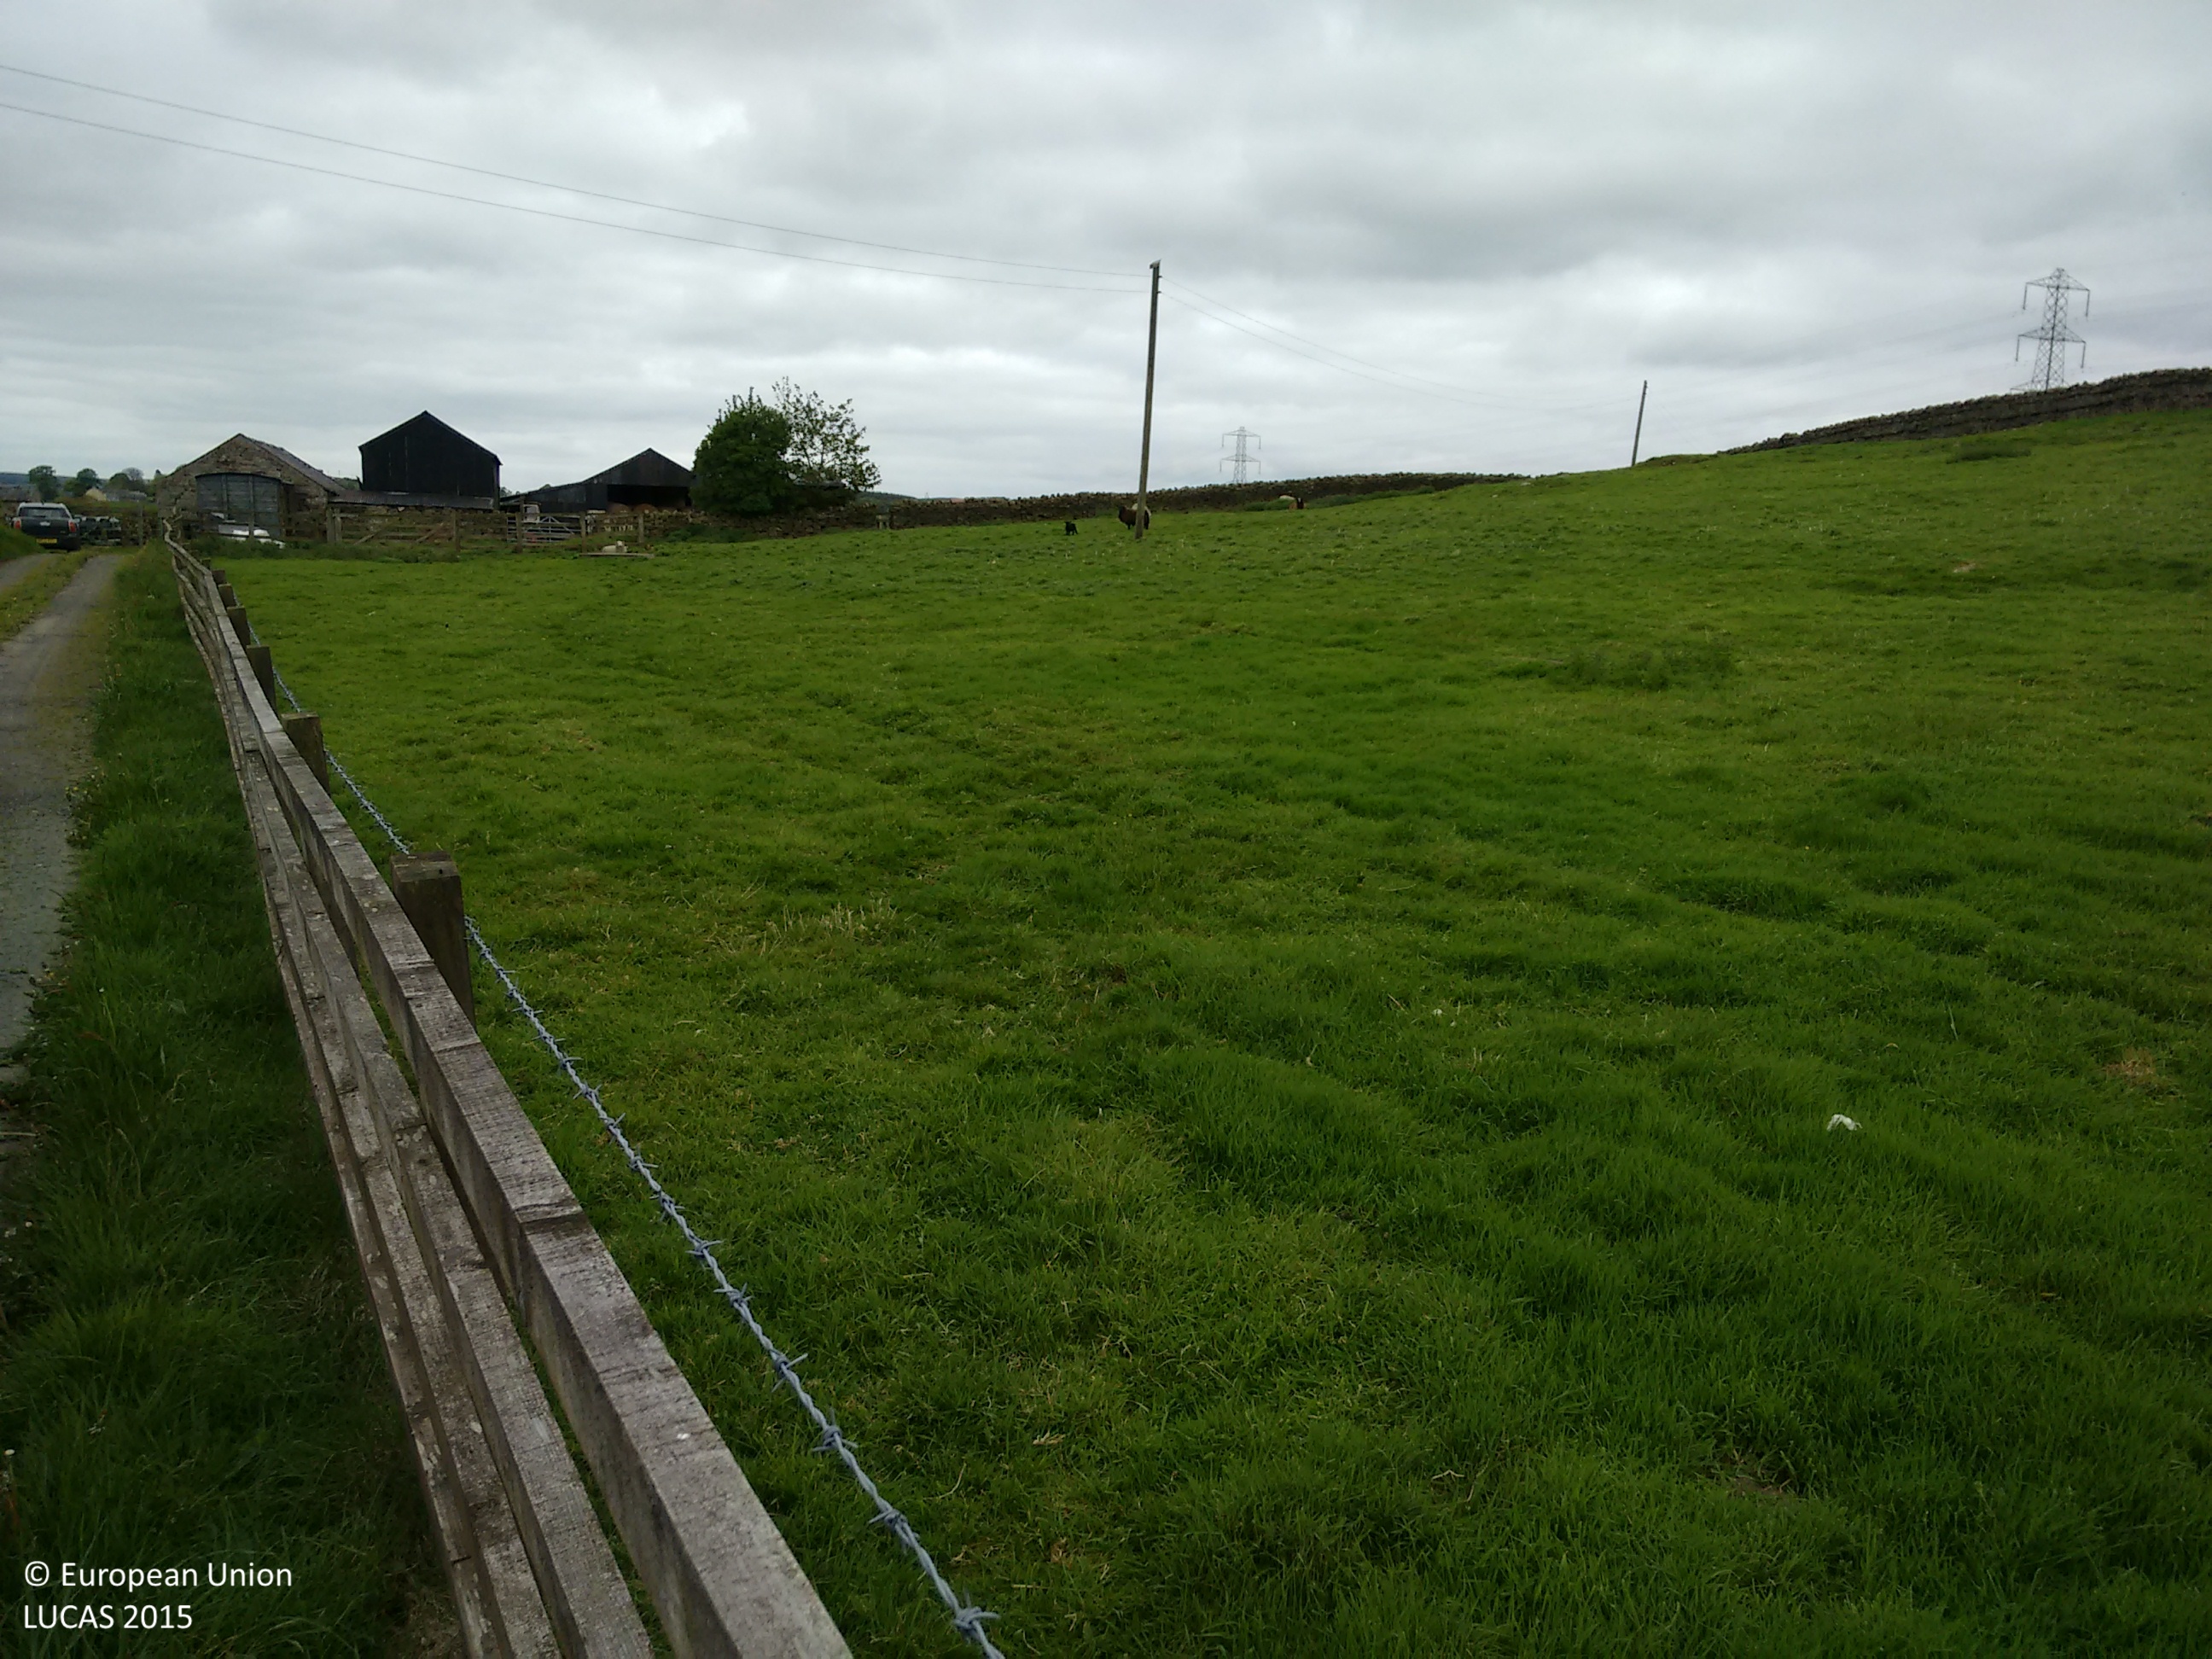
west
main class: Grassland
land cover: Grassland without tree/shrub cover
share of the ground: > 75 %
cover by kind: herbaceous plants 100 %
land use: Agriculture (excluding fallow land and kitchen gardens)
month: May
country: GB
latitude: 54.9773
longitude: -2.4517
